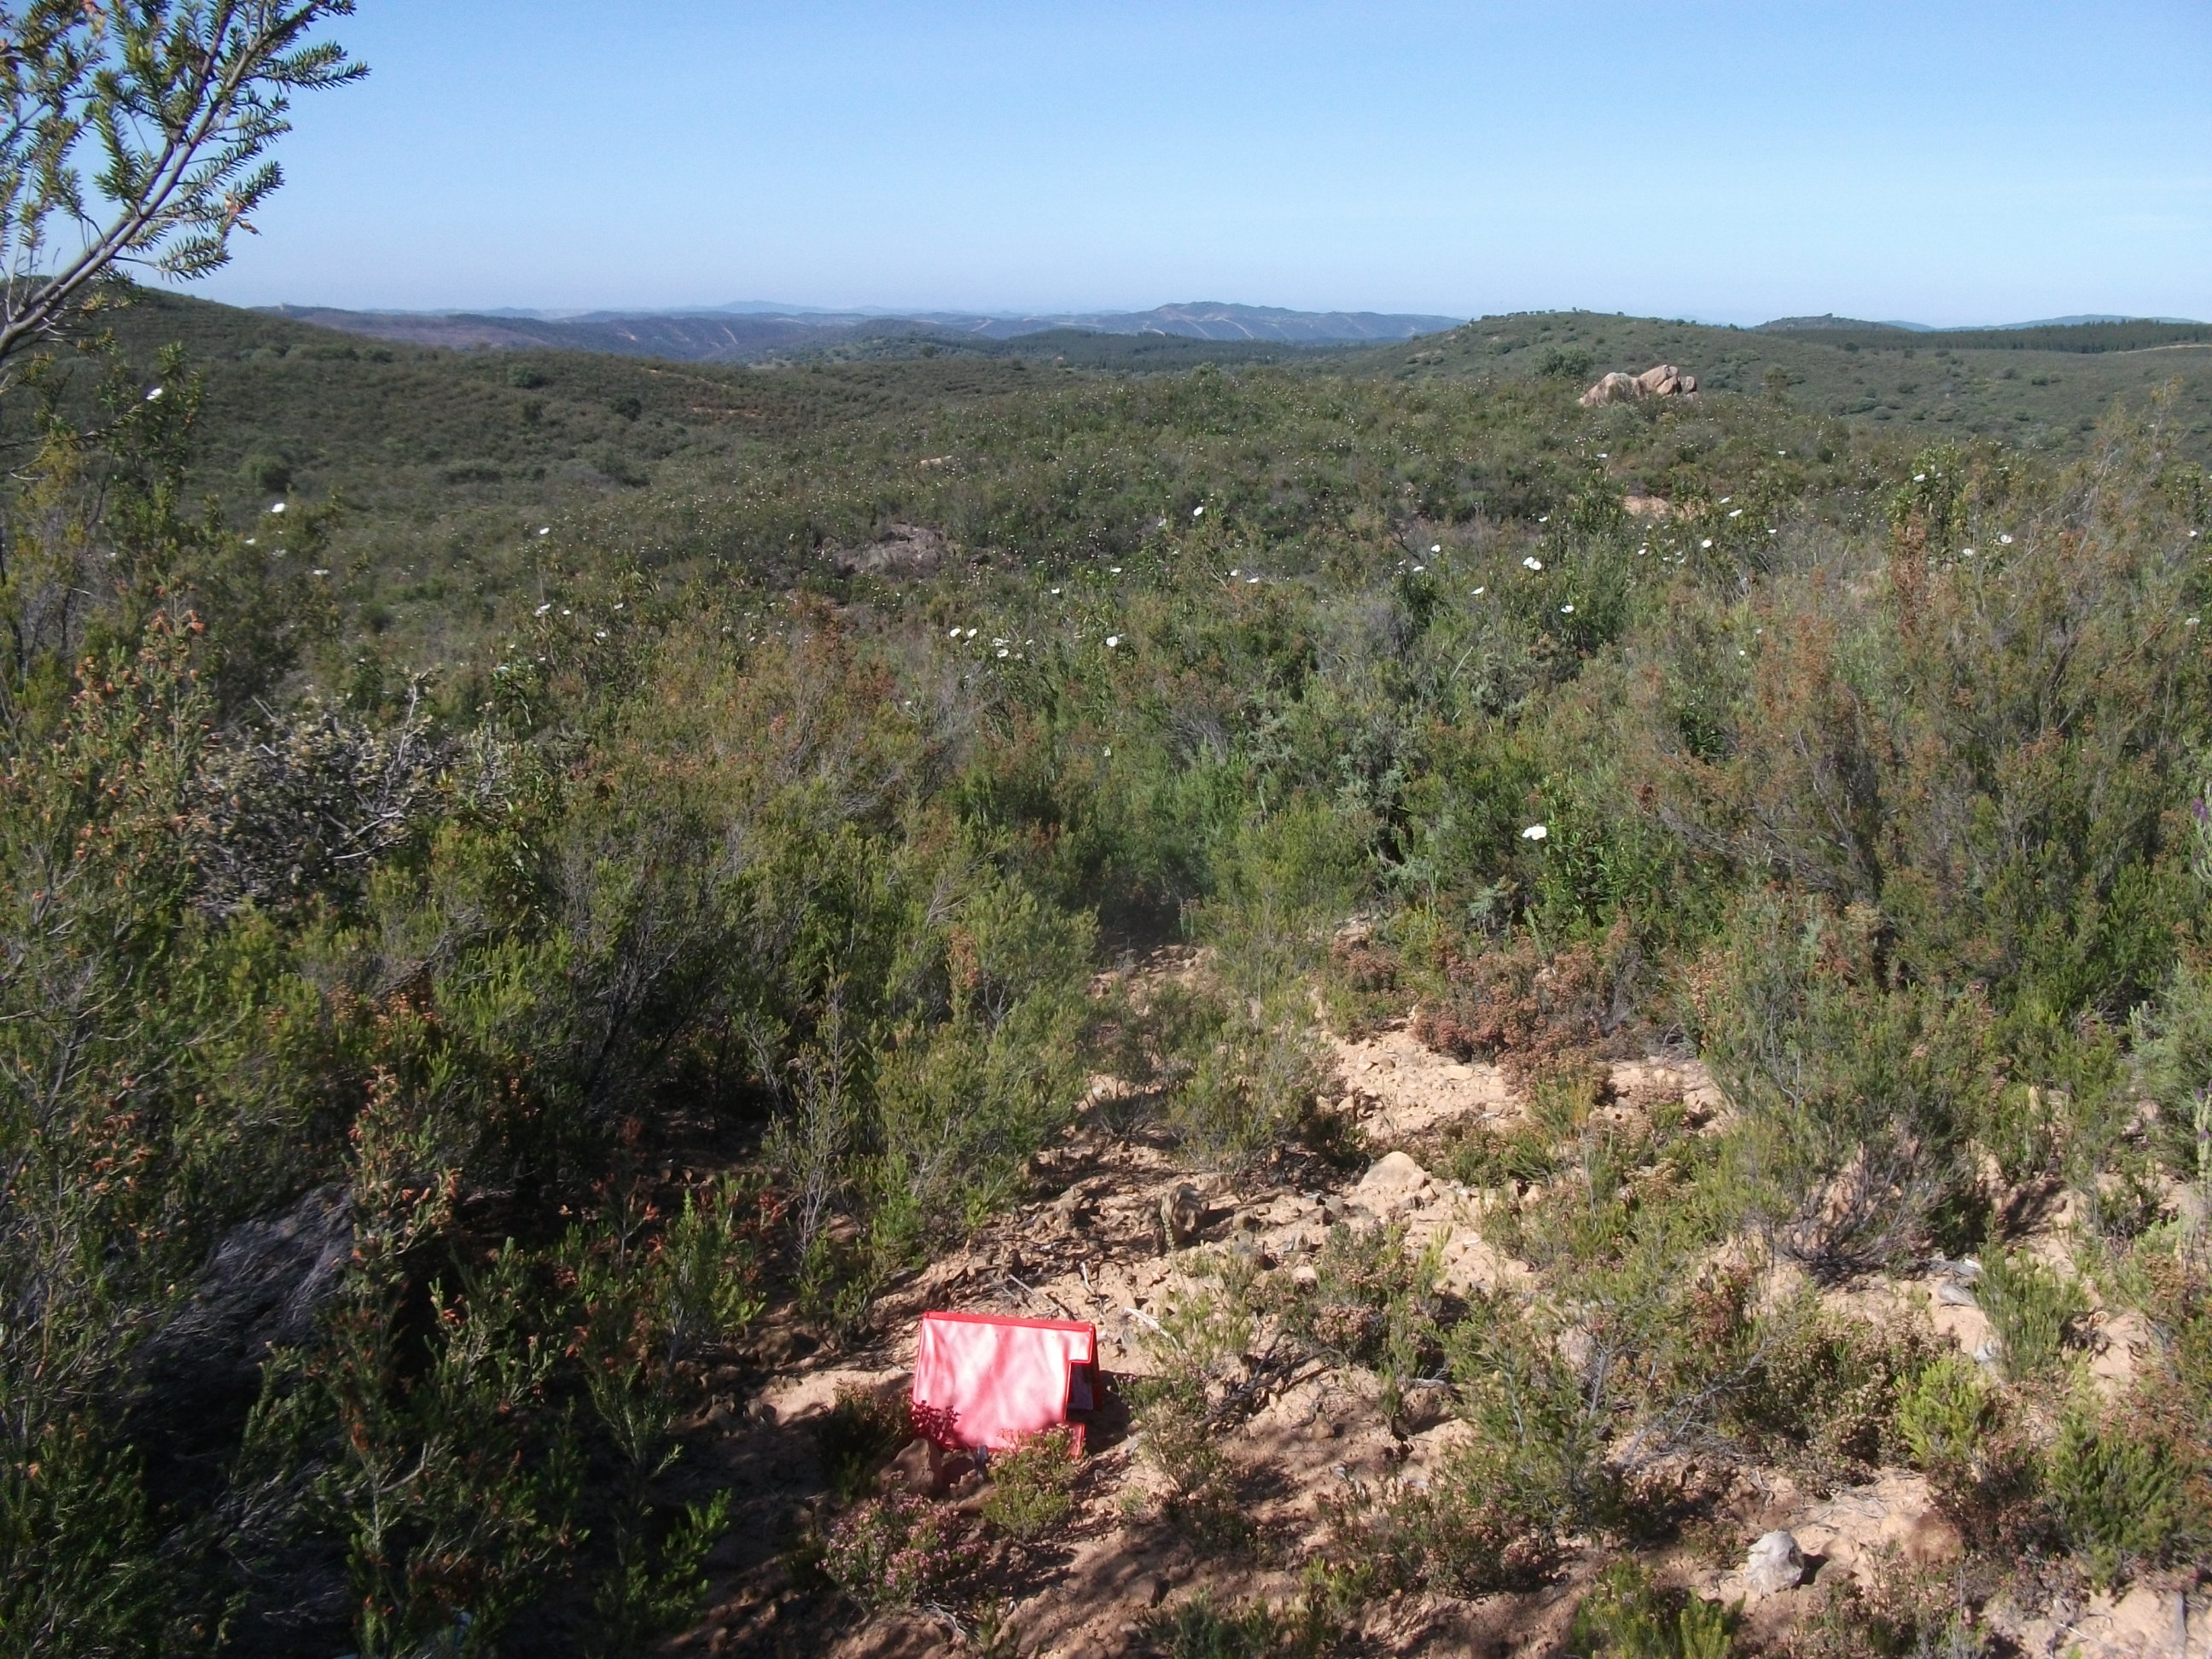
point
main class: Shrubland
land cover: Shrubland without tree cover
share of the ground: > 75 %
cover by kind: shrubs 95 %, unconsolidated bare surface 5 %
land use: Semi-natural and natural areas not in use
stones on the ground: 10 - 25 %
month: April
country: ES
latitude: 37.8501
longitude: -6.5787
